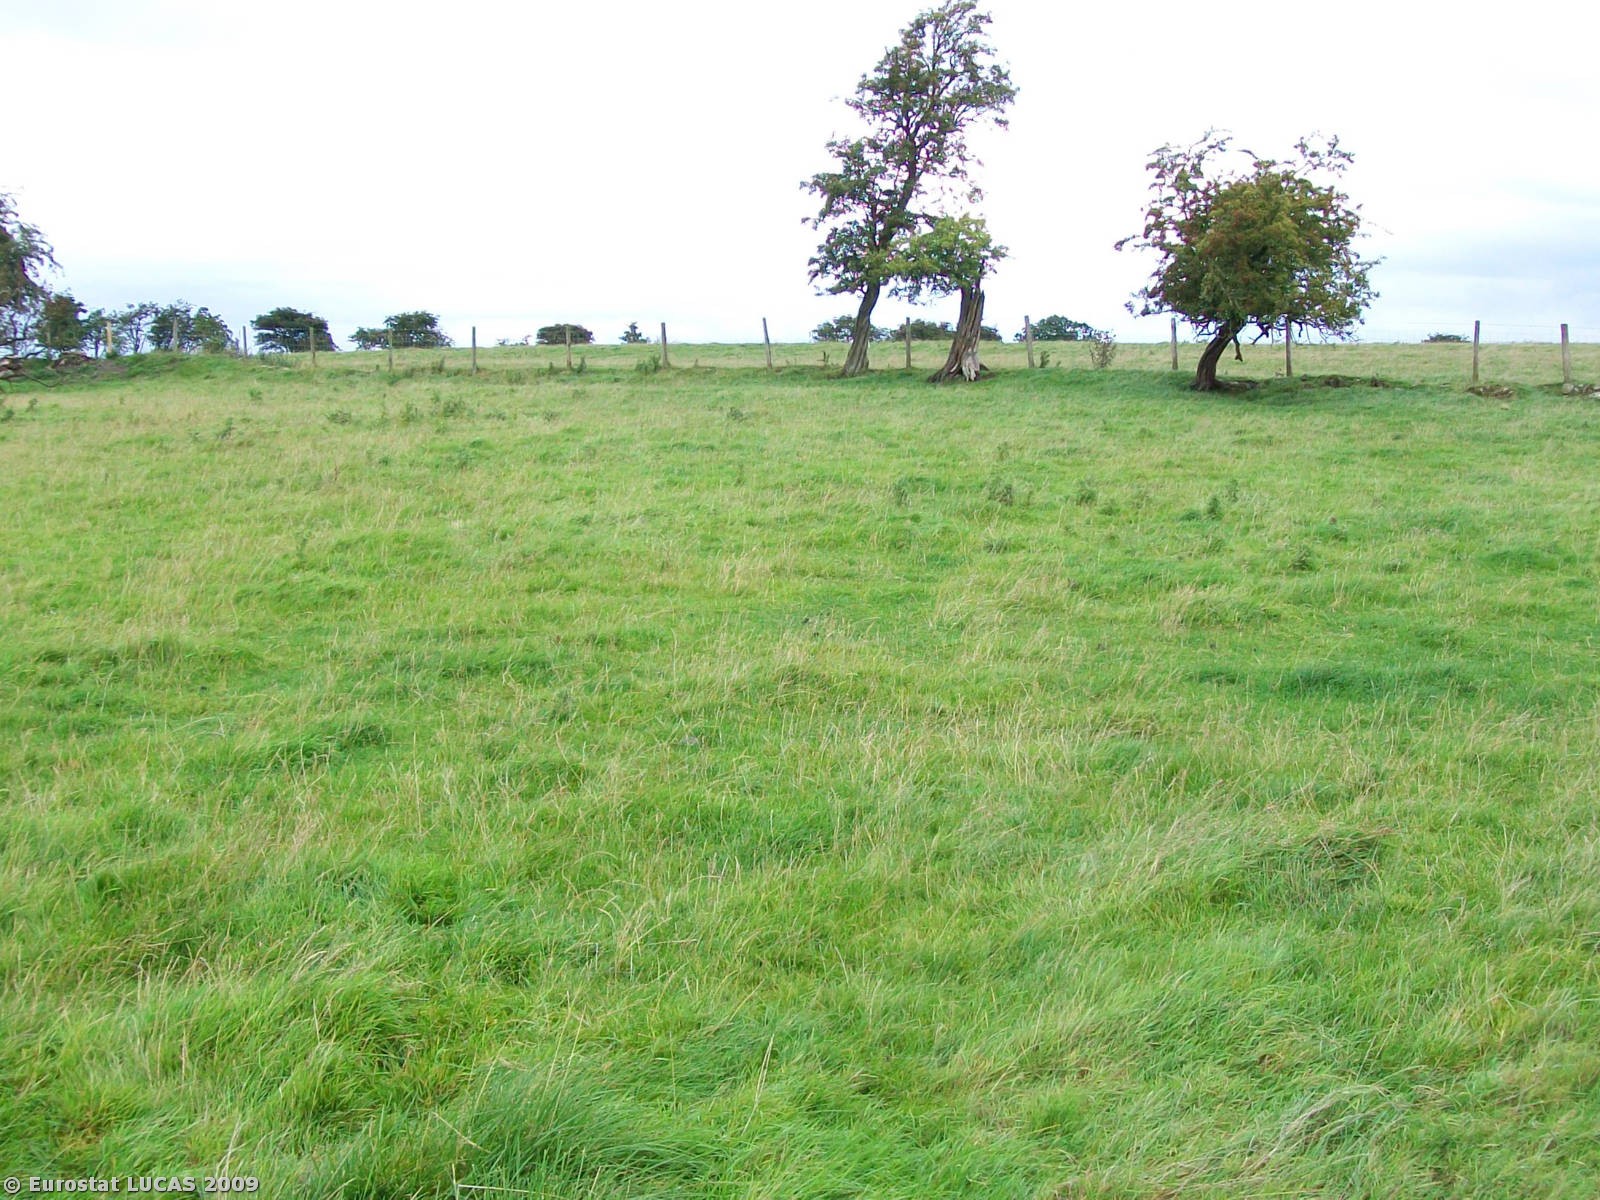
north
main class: Grassland
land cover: Grassland without tree/shrub cover
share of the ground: > 75 %
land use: Agriculture (excluding fallow land and kitchen gardens)
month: September
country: GB
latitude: 55.0228
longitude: -1.9891
